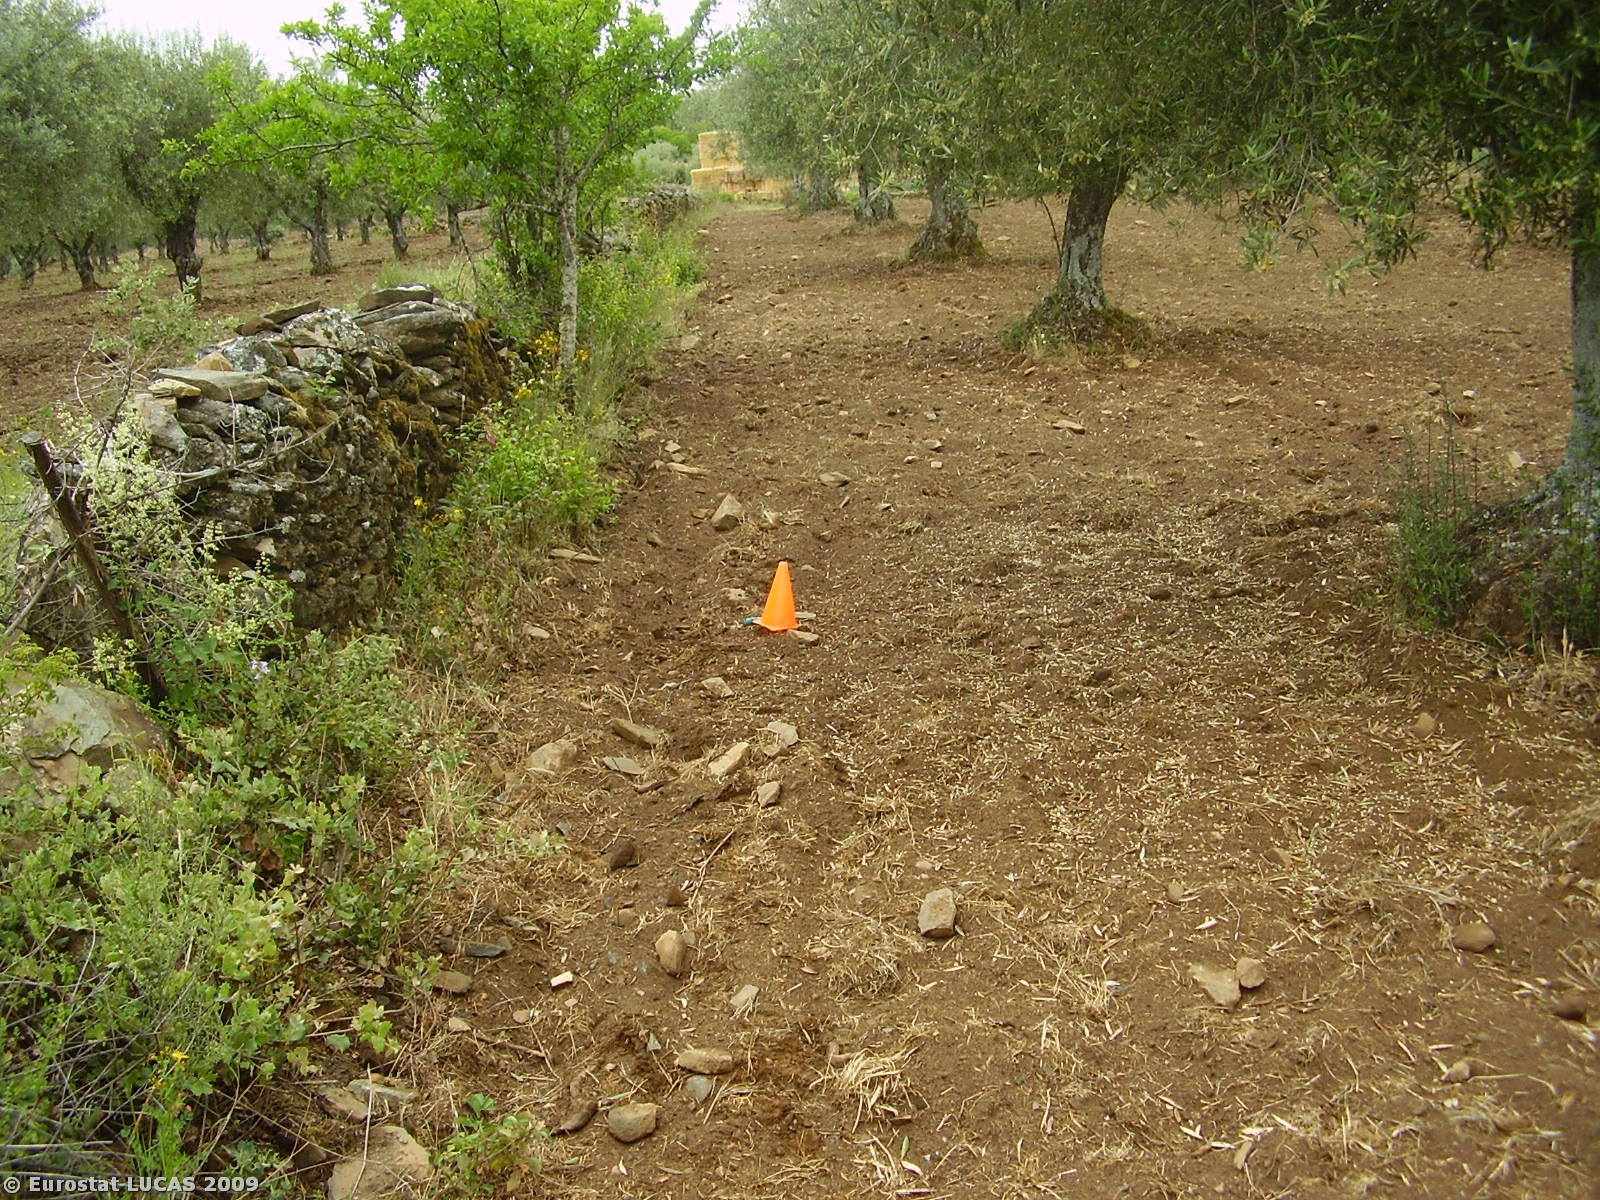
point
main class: Cropland
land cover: Olive groves
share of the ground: 10 - 25 %
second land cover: Bare land
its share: > 75 %
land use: Agriculture (excluding fallow land and kitchen gardens)
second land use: Unused
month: June
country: PT
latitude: 41.5540
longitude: -6.7875
